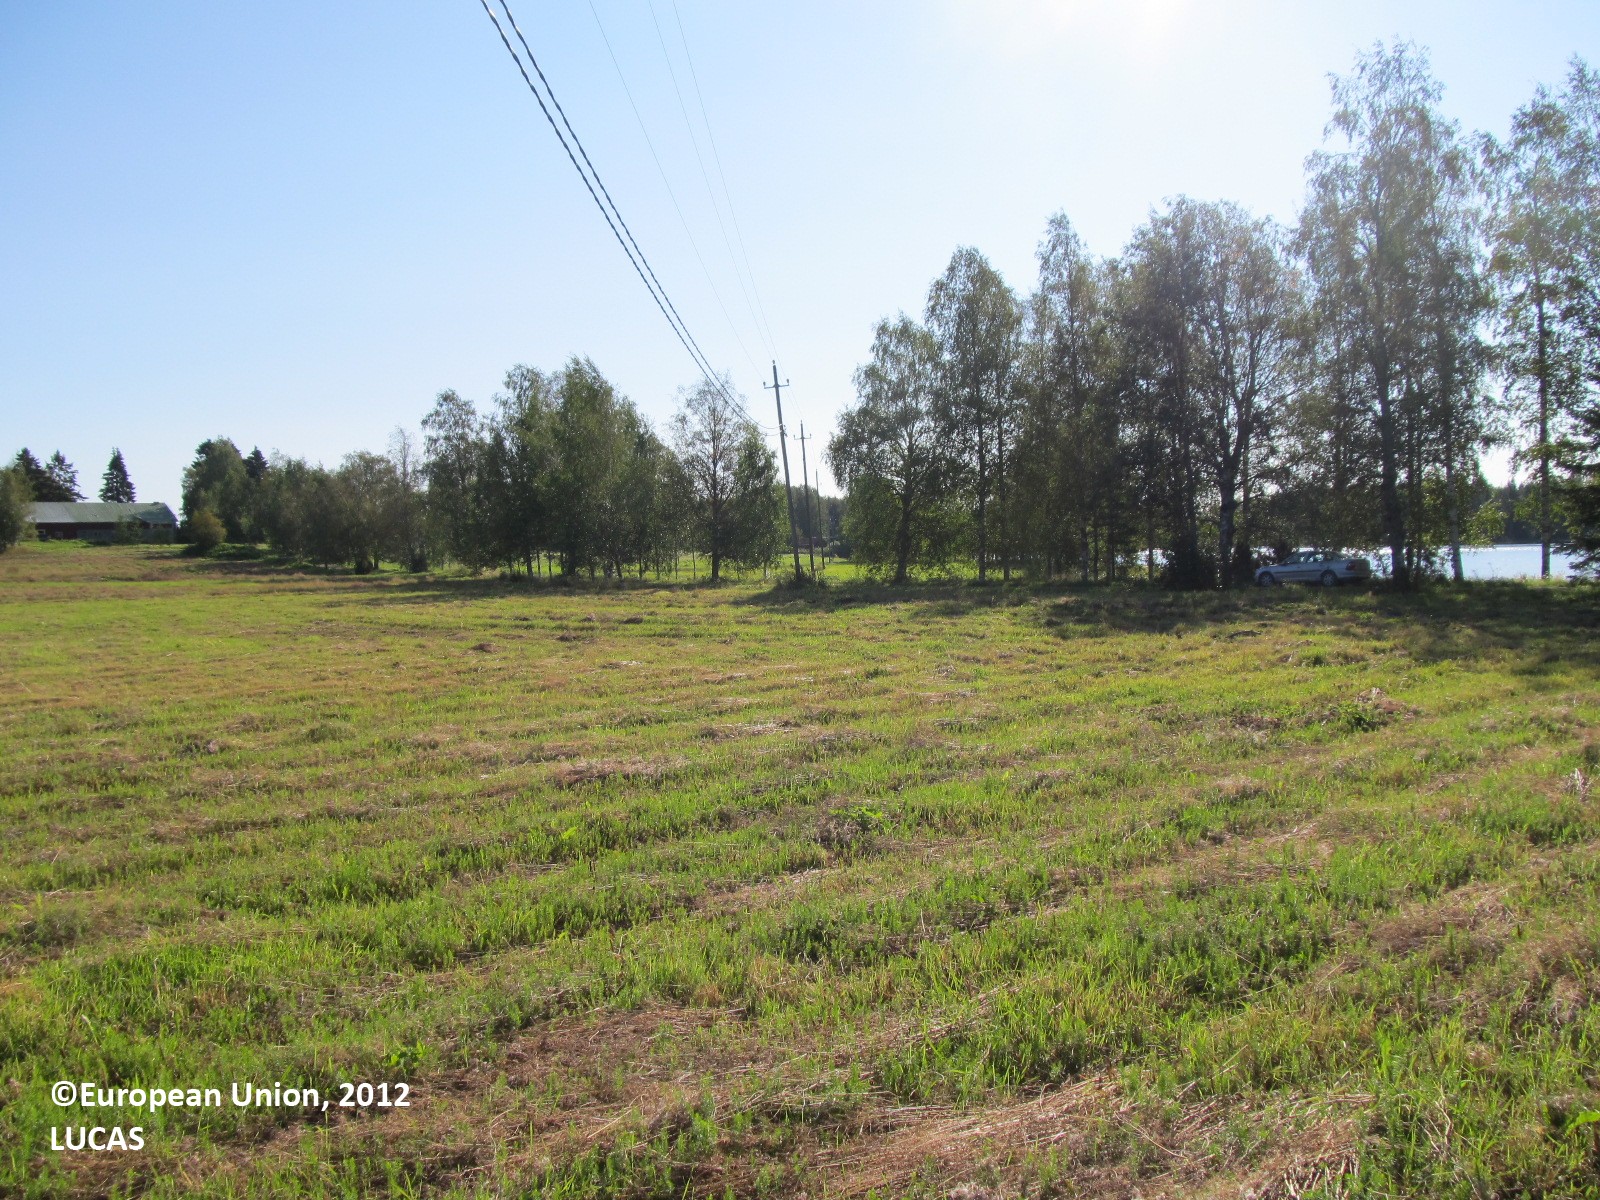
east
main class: Cropland
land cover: Temporary grasslands
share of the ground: 50 - 75 %
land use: Agriculture (excluding fallow land and kitchen gardens)
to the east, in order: Temporary grasslands; Electric lines; Temporary grasslands; Ditches and canals; Grass margins; Lines of trees; Paved roads, cycling and walking lanes; Grass margins; Lines of trees; Ditches and canals; Temporary grasslands; Ditches and canals; Temporary grasslands
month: August
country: FI
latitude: 61.8325
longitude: 27.5122
